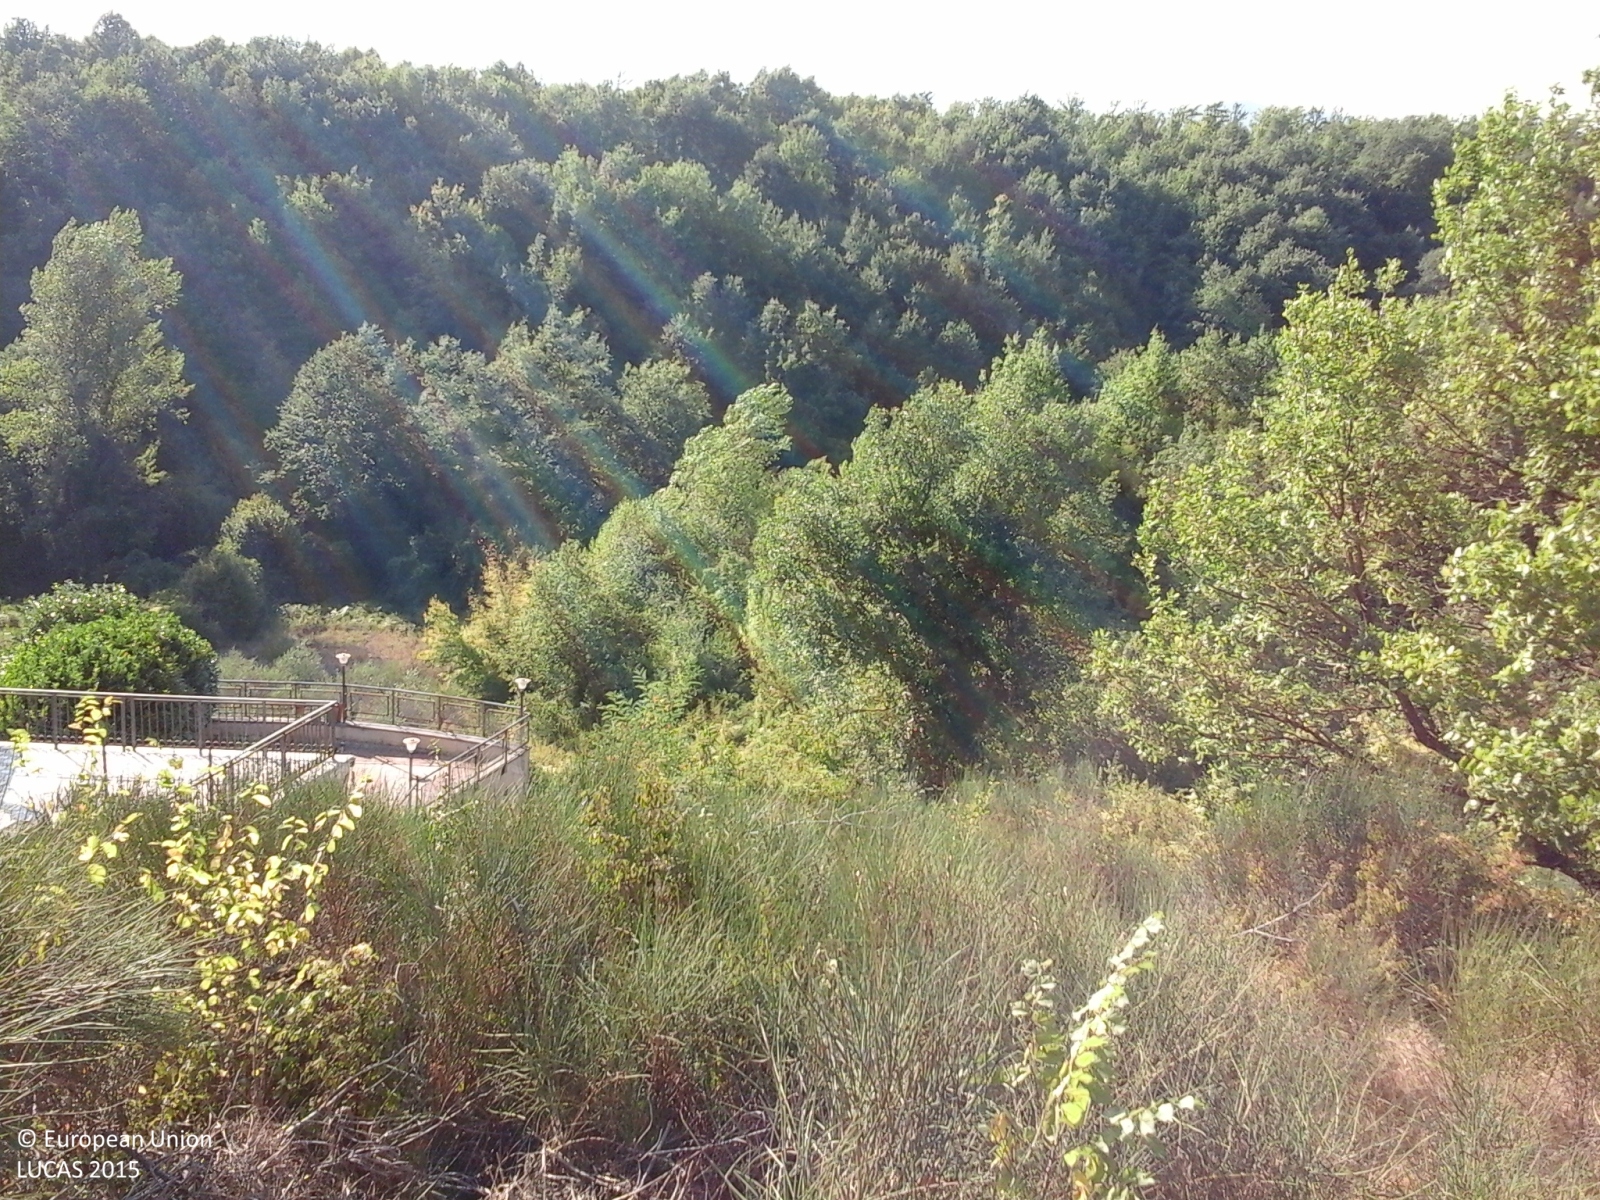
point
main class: Woodland
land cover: Broadleaved woodland
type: thermophilous deciduous forest
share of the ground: > 75 %
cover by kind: broadleaved forest trees 85 %, shrubs 10 %, herbaceous plants 5 %
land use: Semi-natural and natural areas not in use
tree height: > 5 m
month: September
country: IT
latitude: 41.5732
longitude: 14.1705
